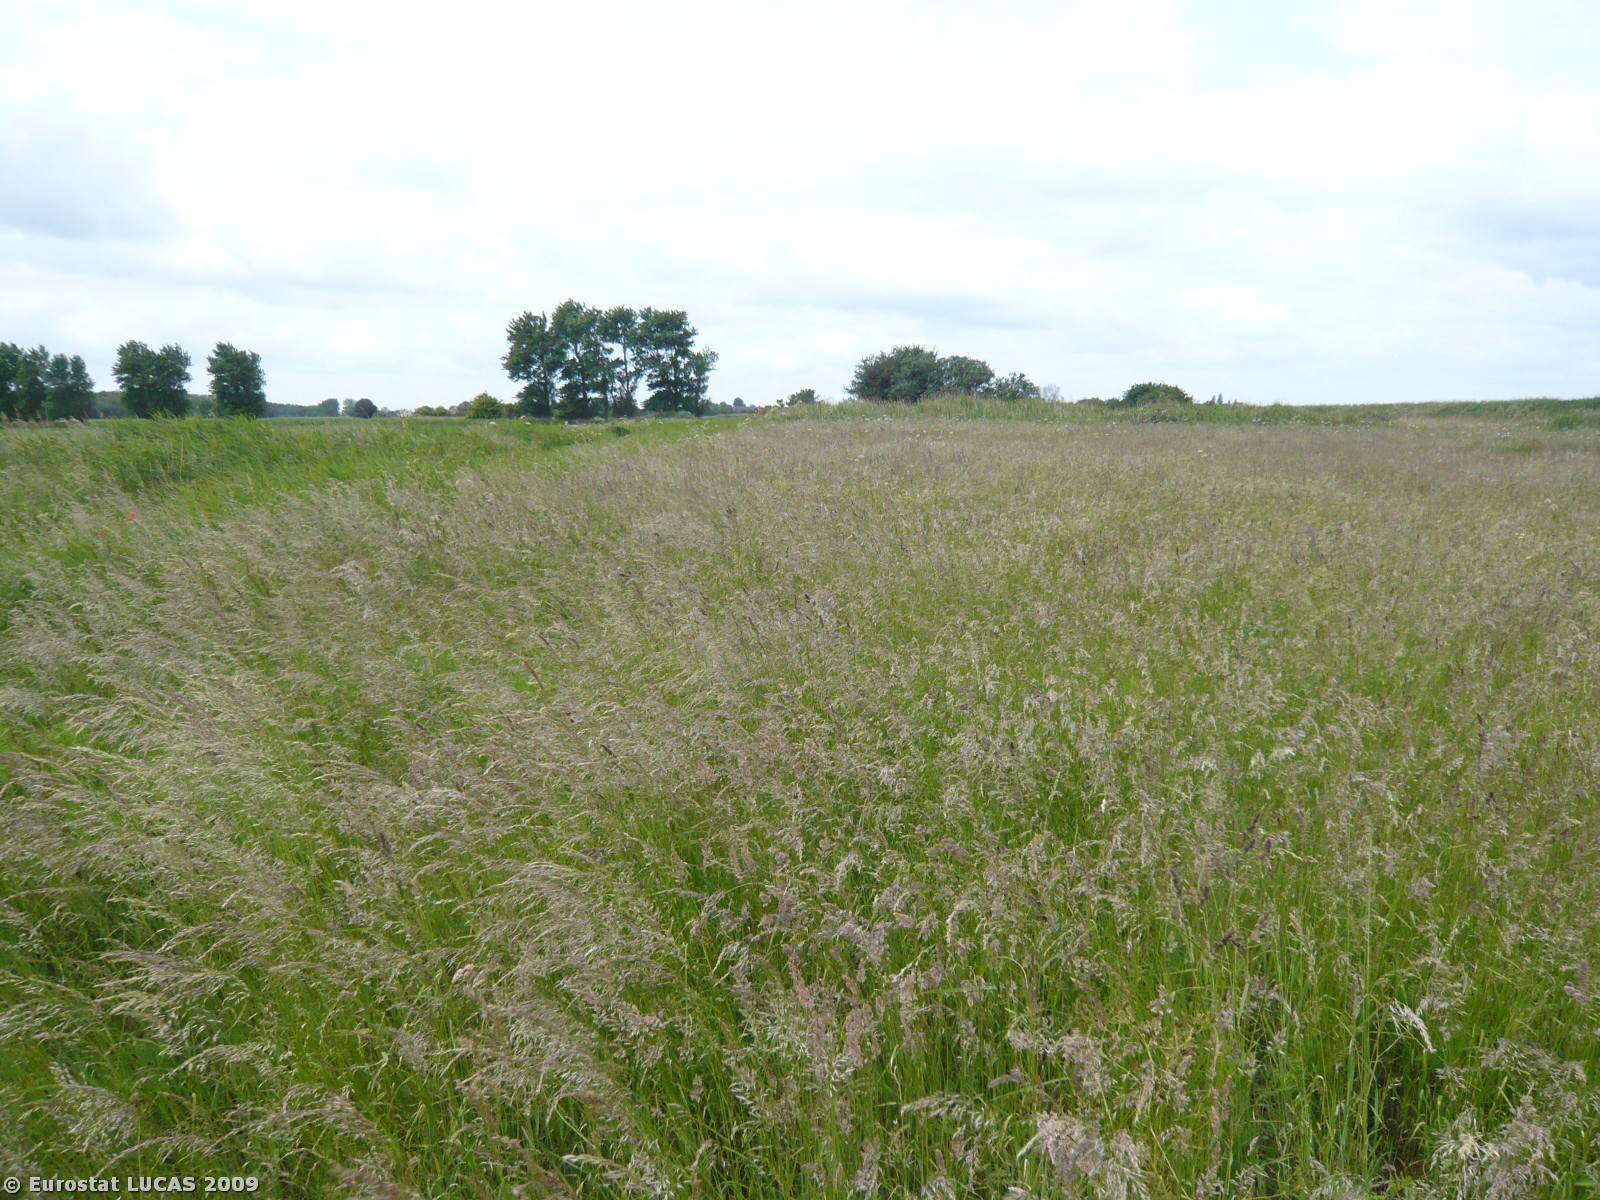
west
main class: Grassland
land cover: Grassland without tree/shrub cover
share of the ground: > 75 %
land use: Fallow land
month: June
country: DK
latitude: 54.9597
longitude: 11.2016
